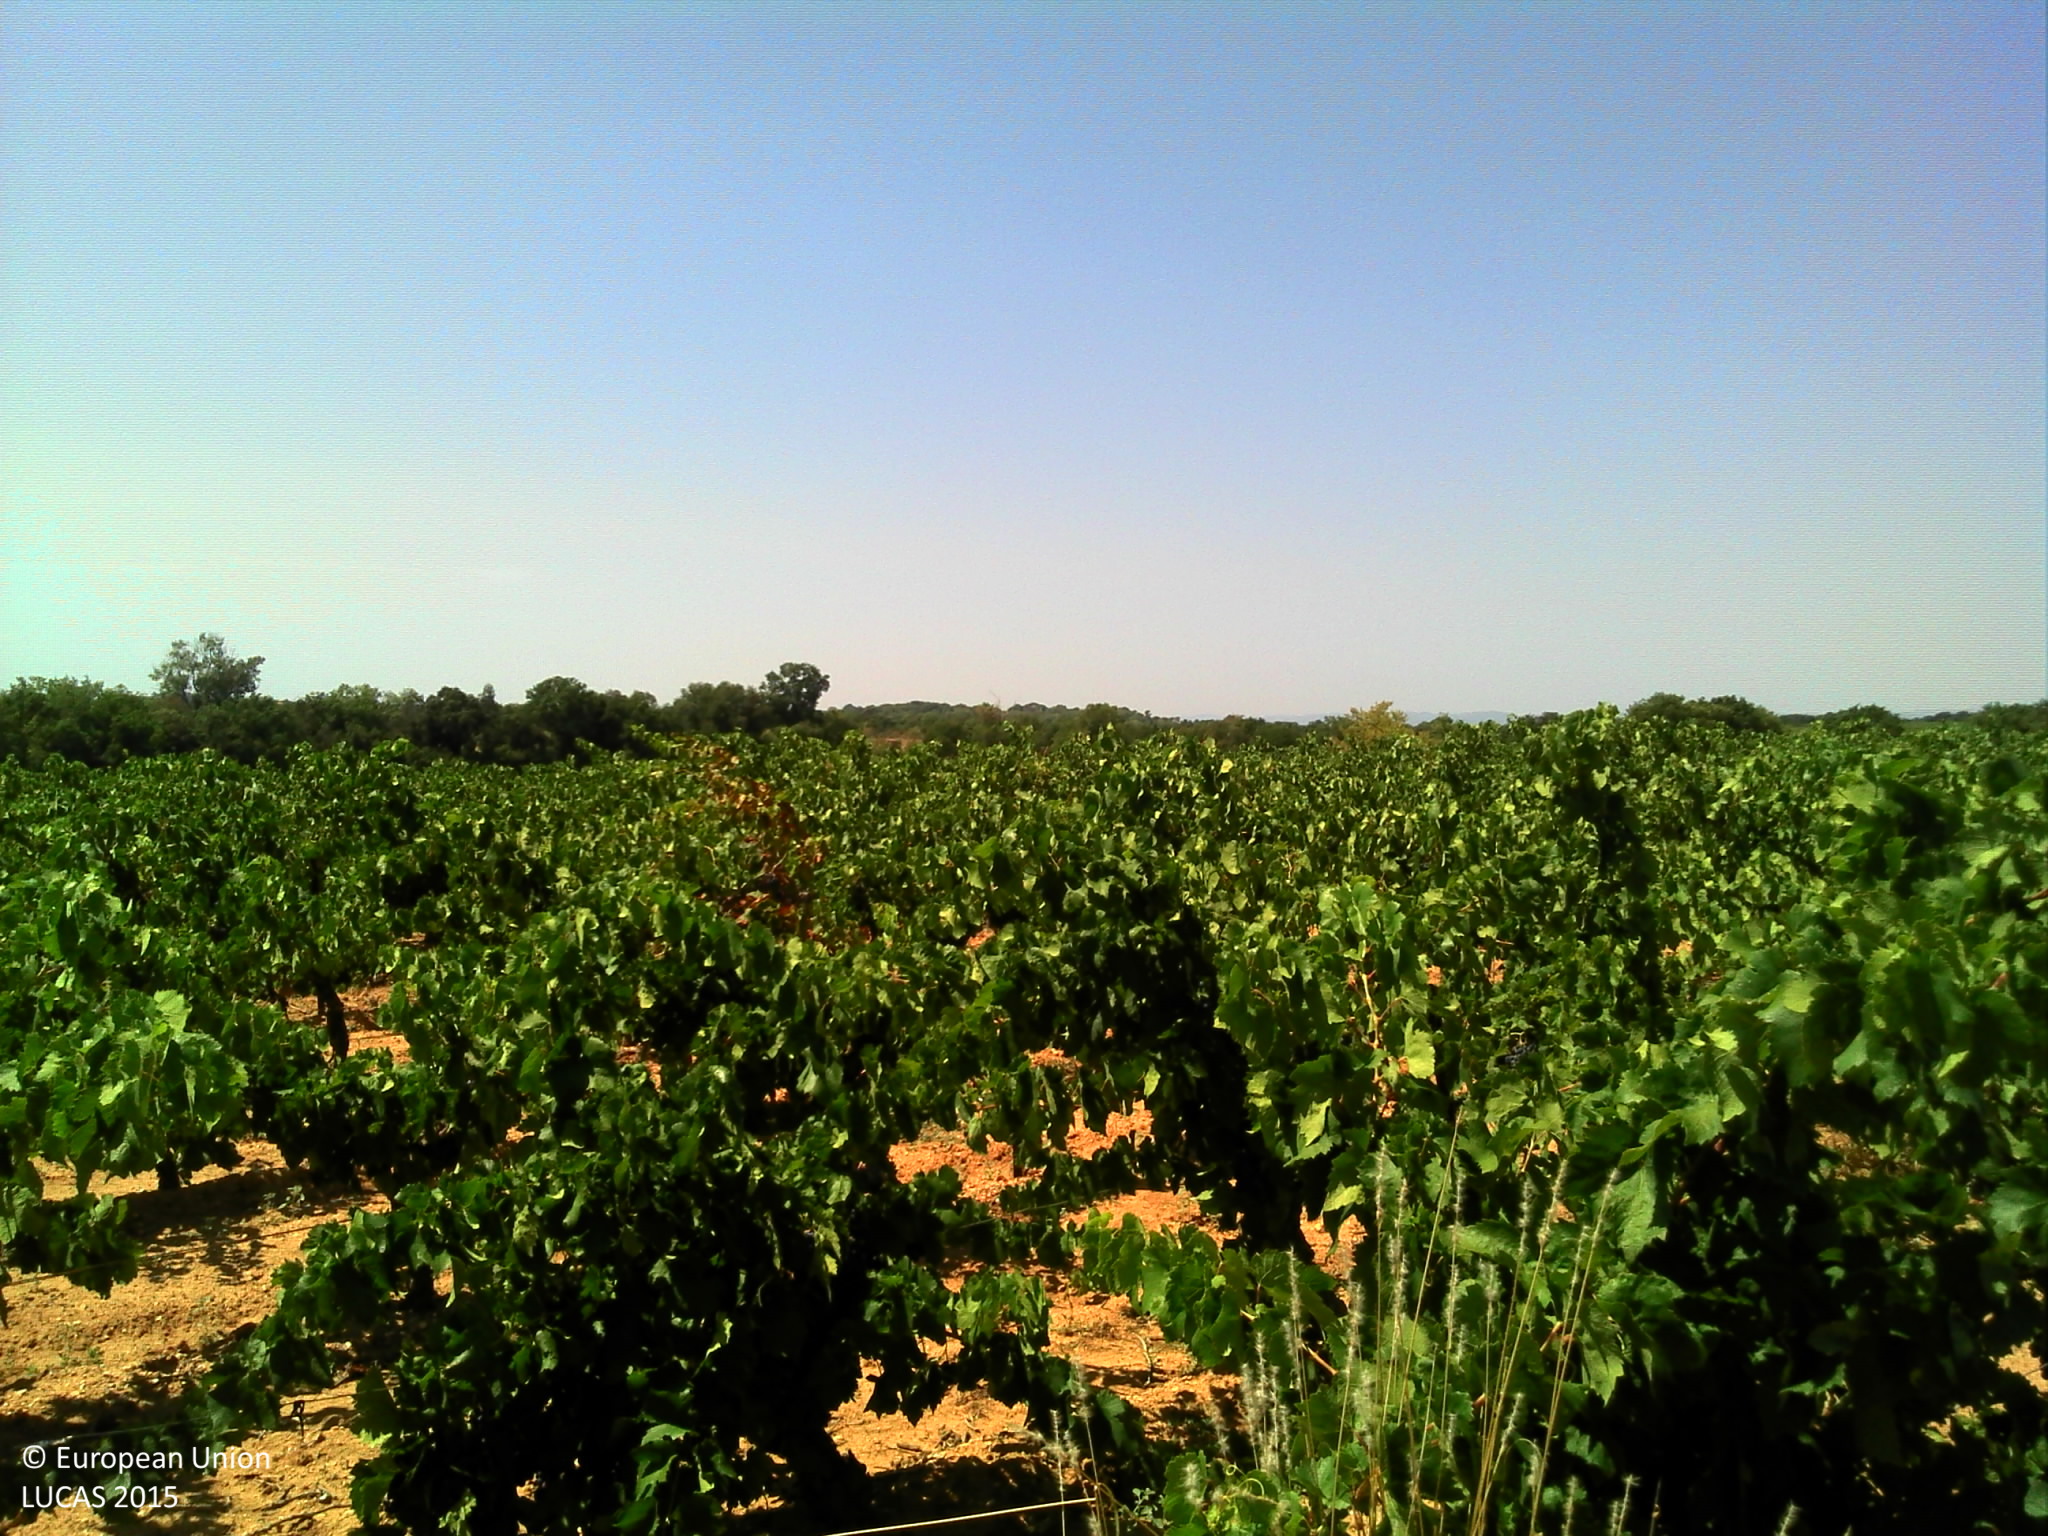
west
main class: Cropland
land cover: Vineyards
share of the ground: 10 - 25 %
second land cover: Other bare soil
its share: > 75 %
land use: Agriculture (excluding fallow land and kitchen gardens)
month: August
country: FR
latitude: 43.4134
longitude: 3.3528
